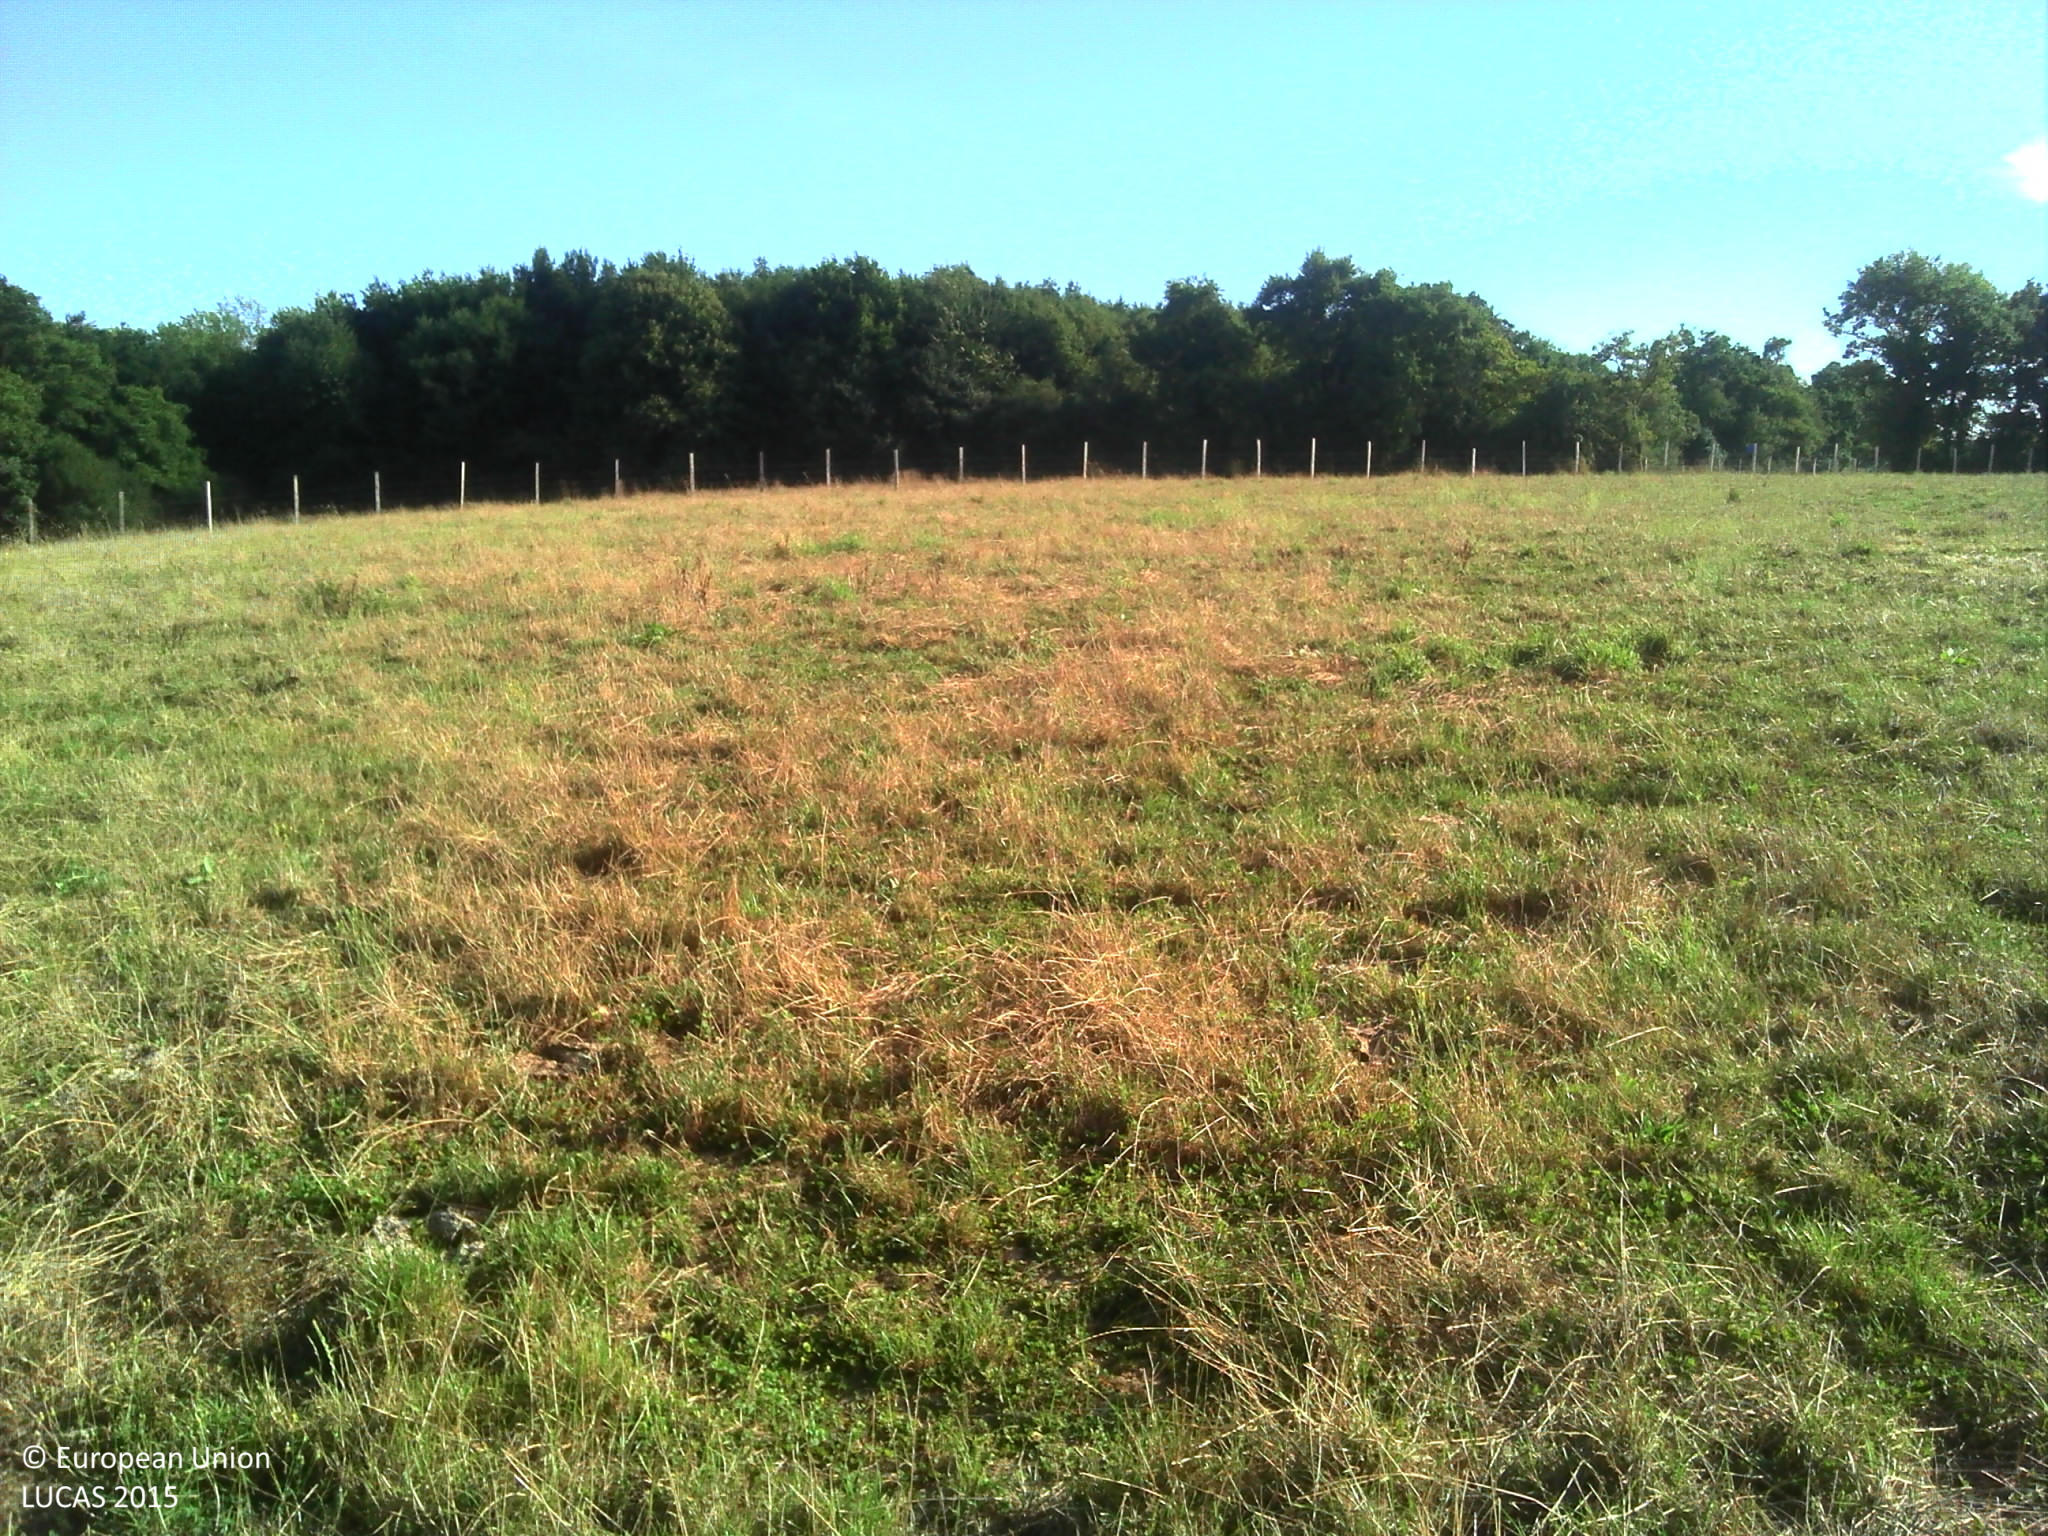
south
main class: Grassland
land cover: Grassland without tree/shrub cover
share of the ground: > 75 %
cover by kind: herbaceous plants 100 %
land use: Agriculture (excluding fallow land and kitchen gardens)
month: August
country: FR
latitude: 46.6515
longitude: -1.7097
